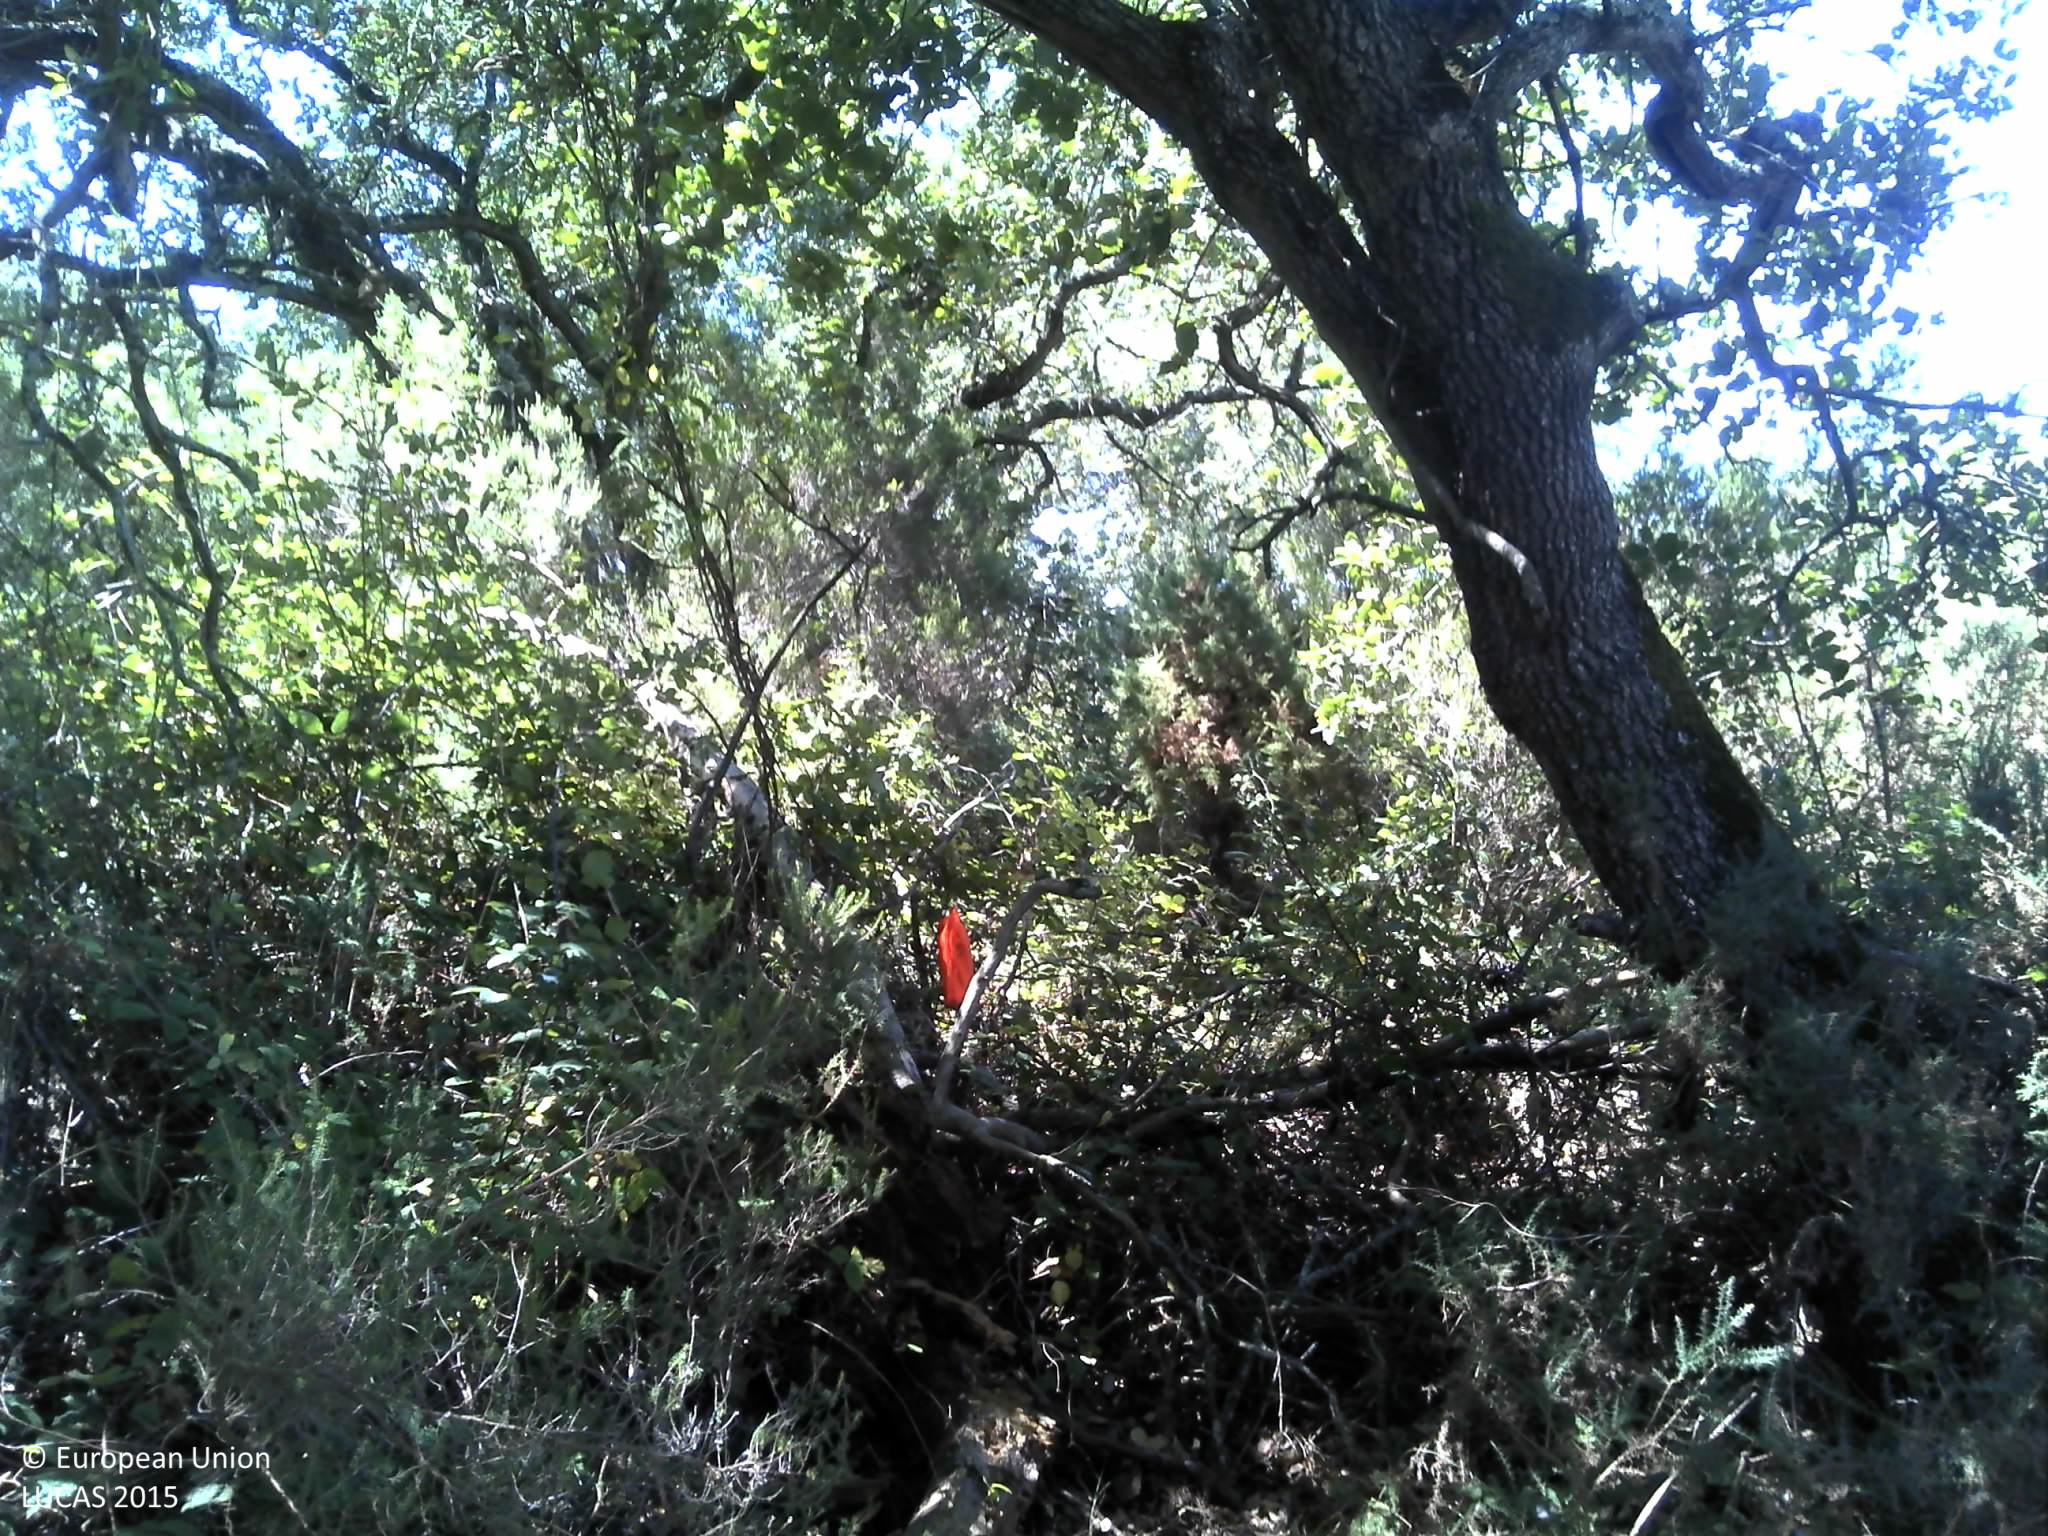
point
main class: Woodland
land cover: Broadleaved woodland
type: broadleaved evergreen forest
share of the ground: 50 - 75 %
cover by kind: broadleaved forest trees 65 %, shrubs 20 %, unconsolidated bare surface 10 %
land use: Forestry
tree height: > 5 m
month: July
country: PT
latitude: 38.9265
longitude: -9.1941
